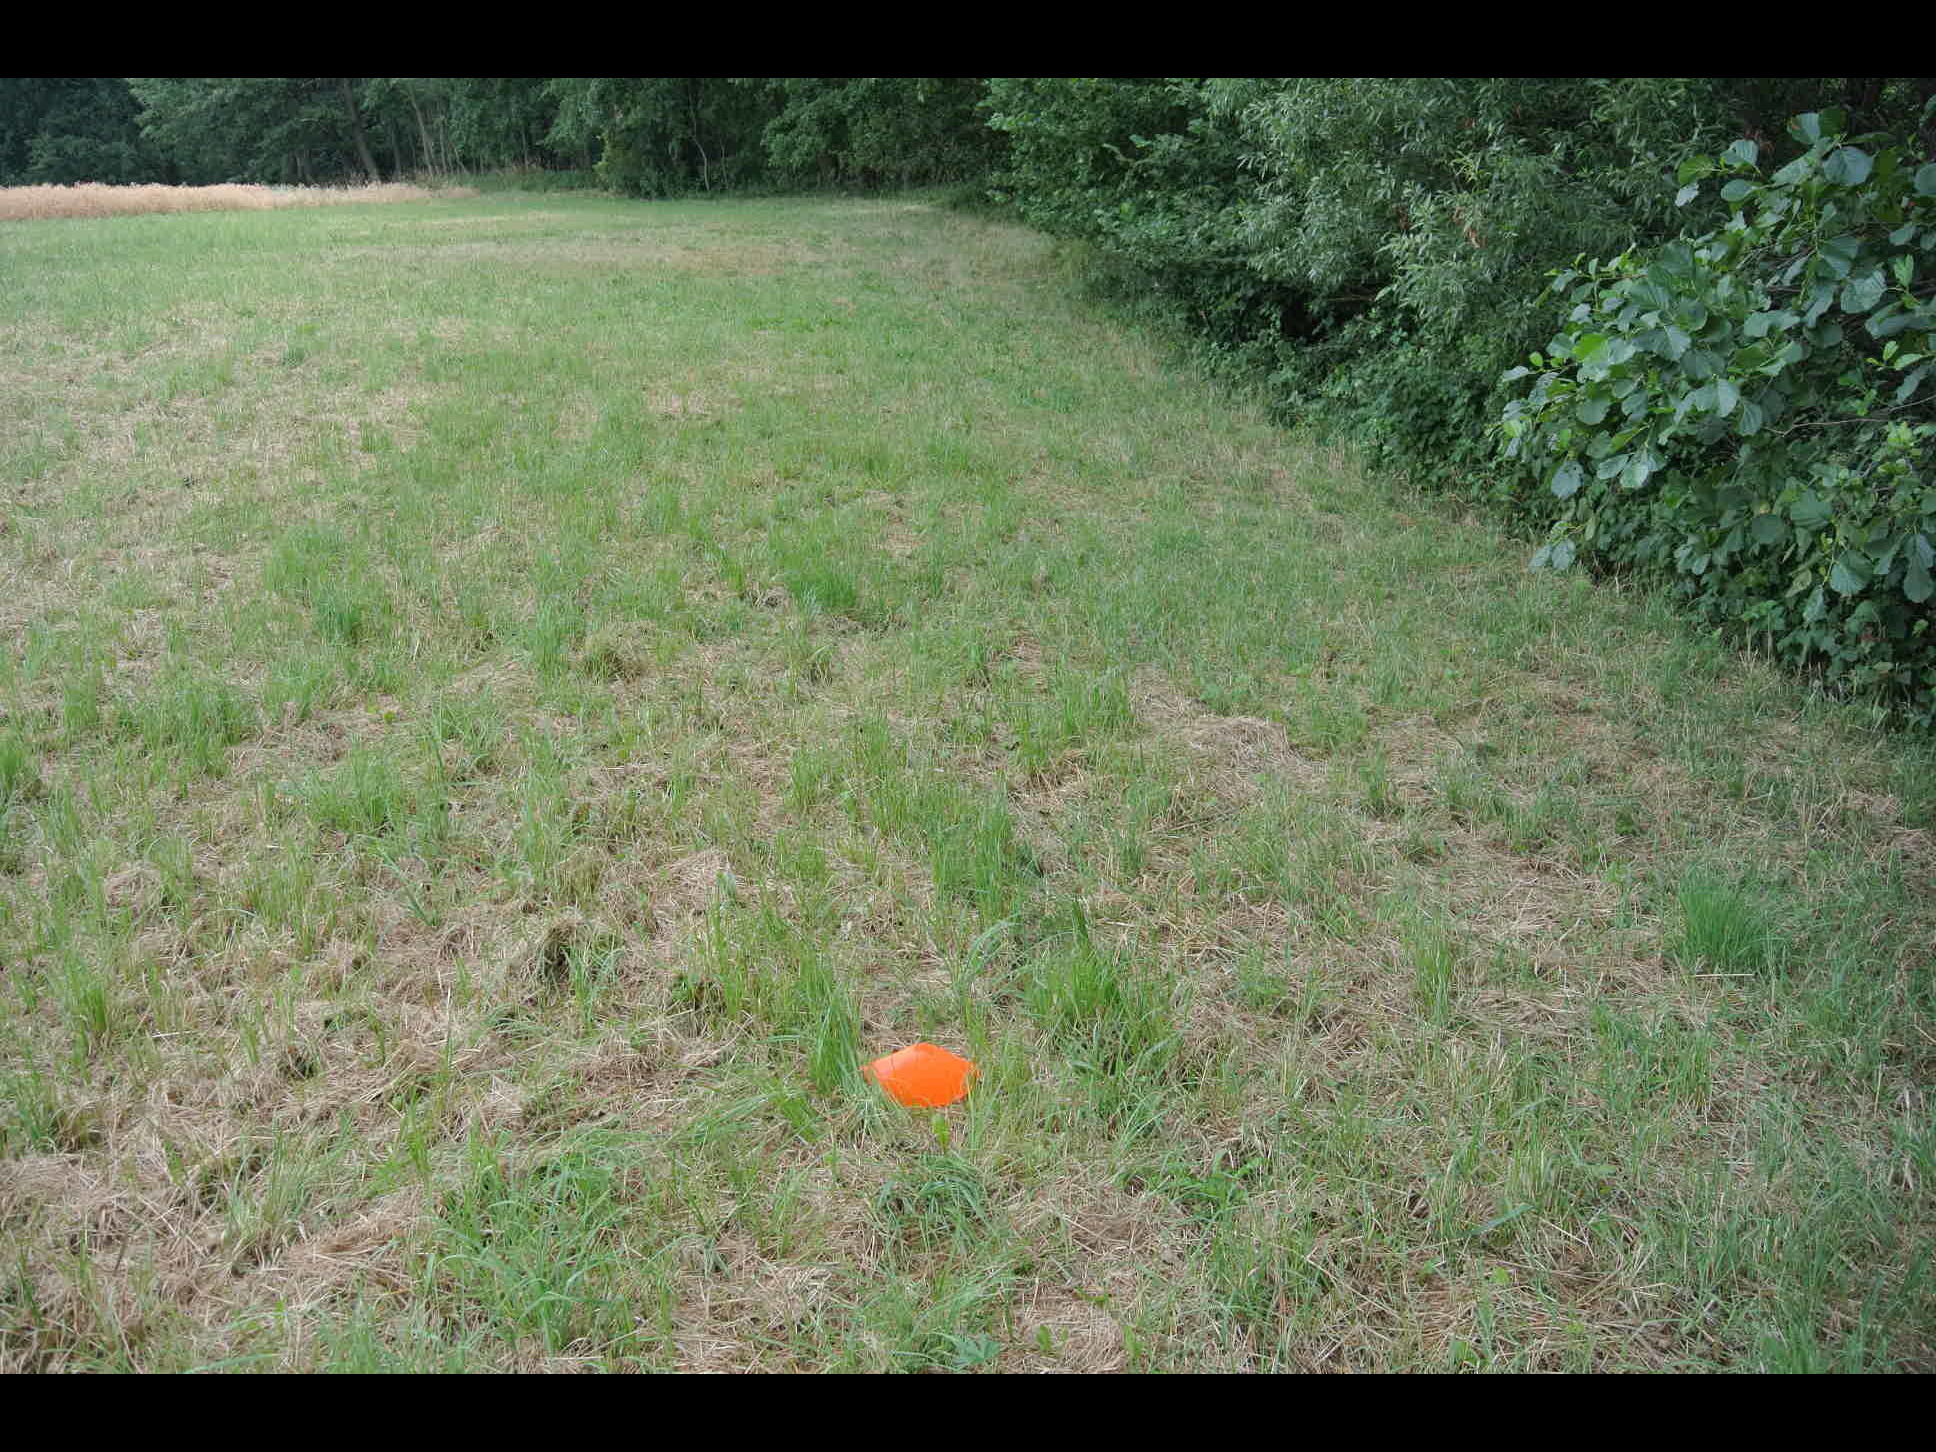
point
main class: Grassland
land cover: Grassland without tree/shrub cover
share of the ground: > 75 %
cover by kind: herbaceous plants 100 %
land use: Agriculture (excluding fallow land and kitchen gardens)
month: July
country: AT
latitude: 47.5684
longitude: 16.3973
